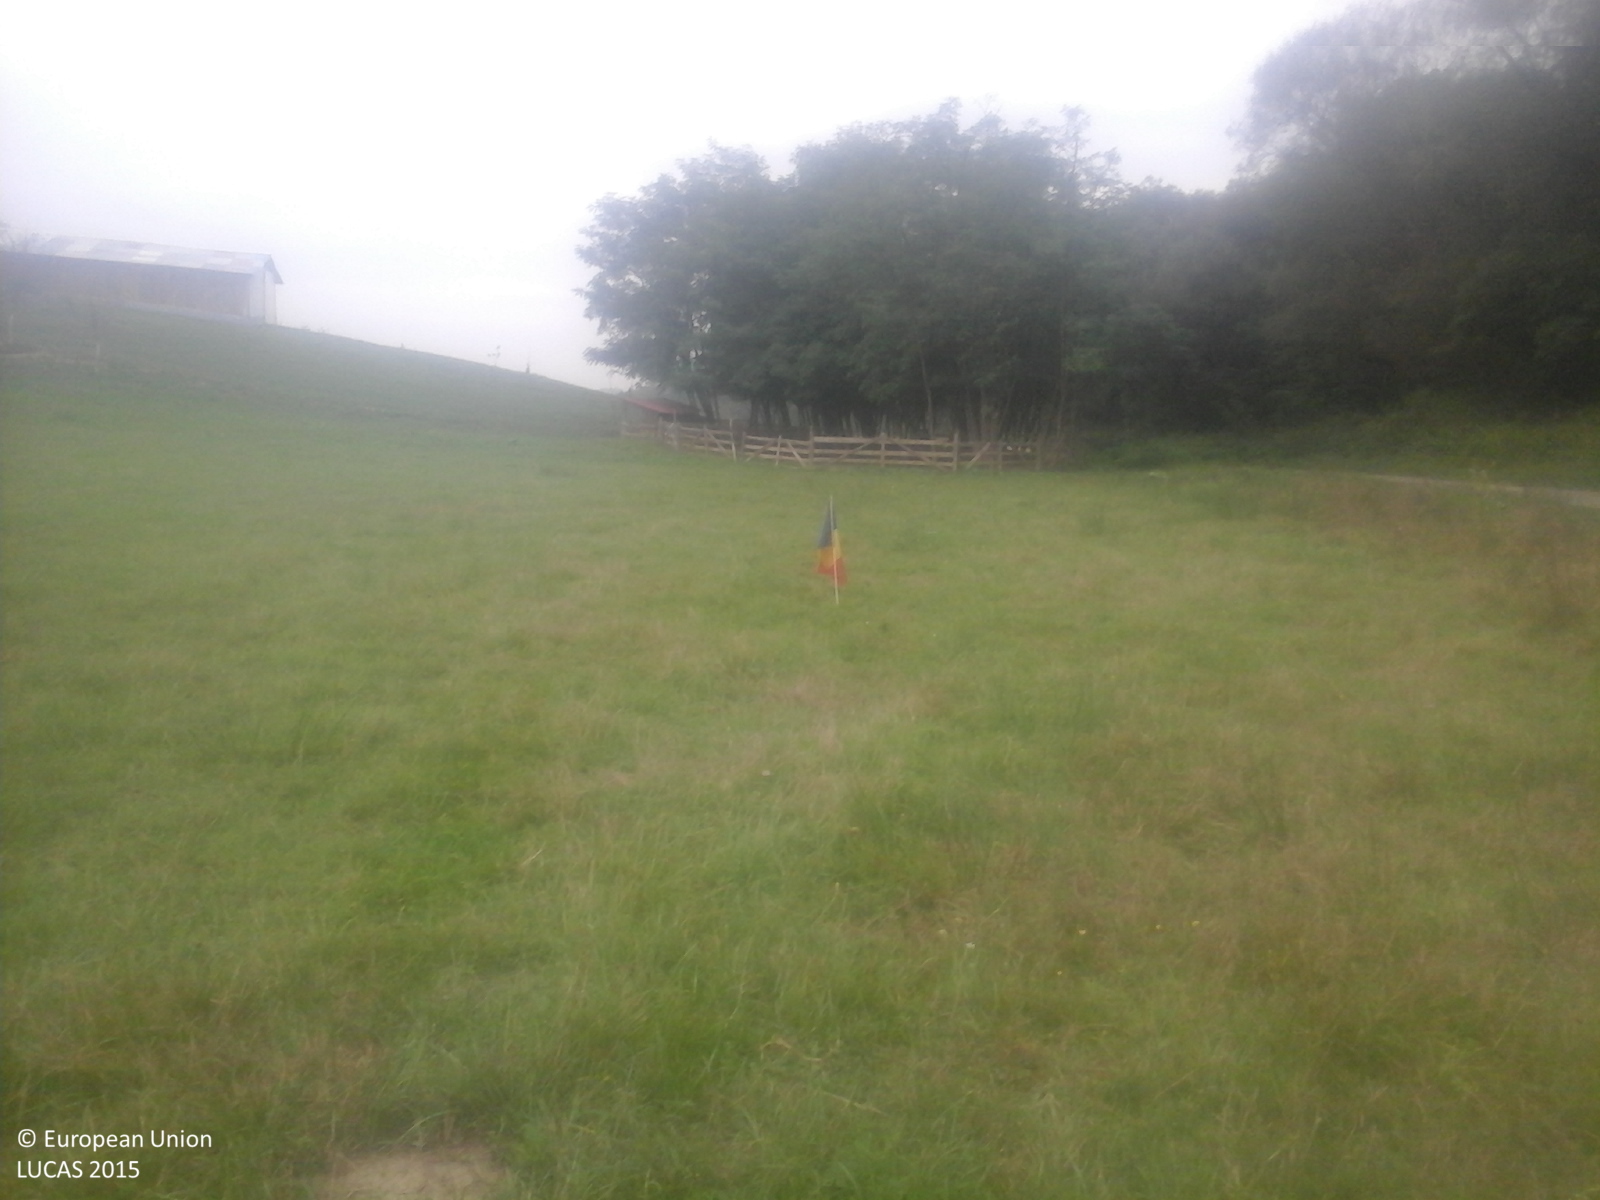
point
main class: Grassland
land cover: Grassland without tree/shrub cover
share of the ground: > 75 %
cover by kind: herbaceous plants 100 %
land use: Agriculture (excluding fallow land and kitchen gardens)
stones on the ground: < 10 %
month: September
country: RO
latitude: 45.5348
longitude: 21.9342
